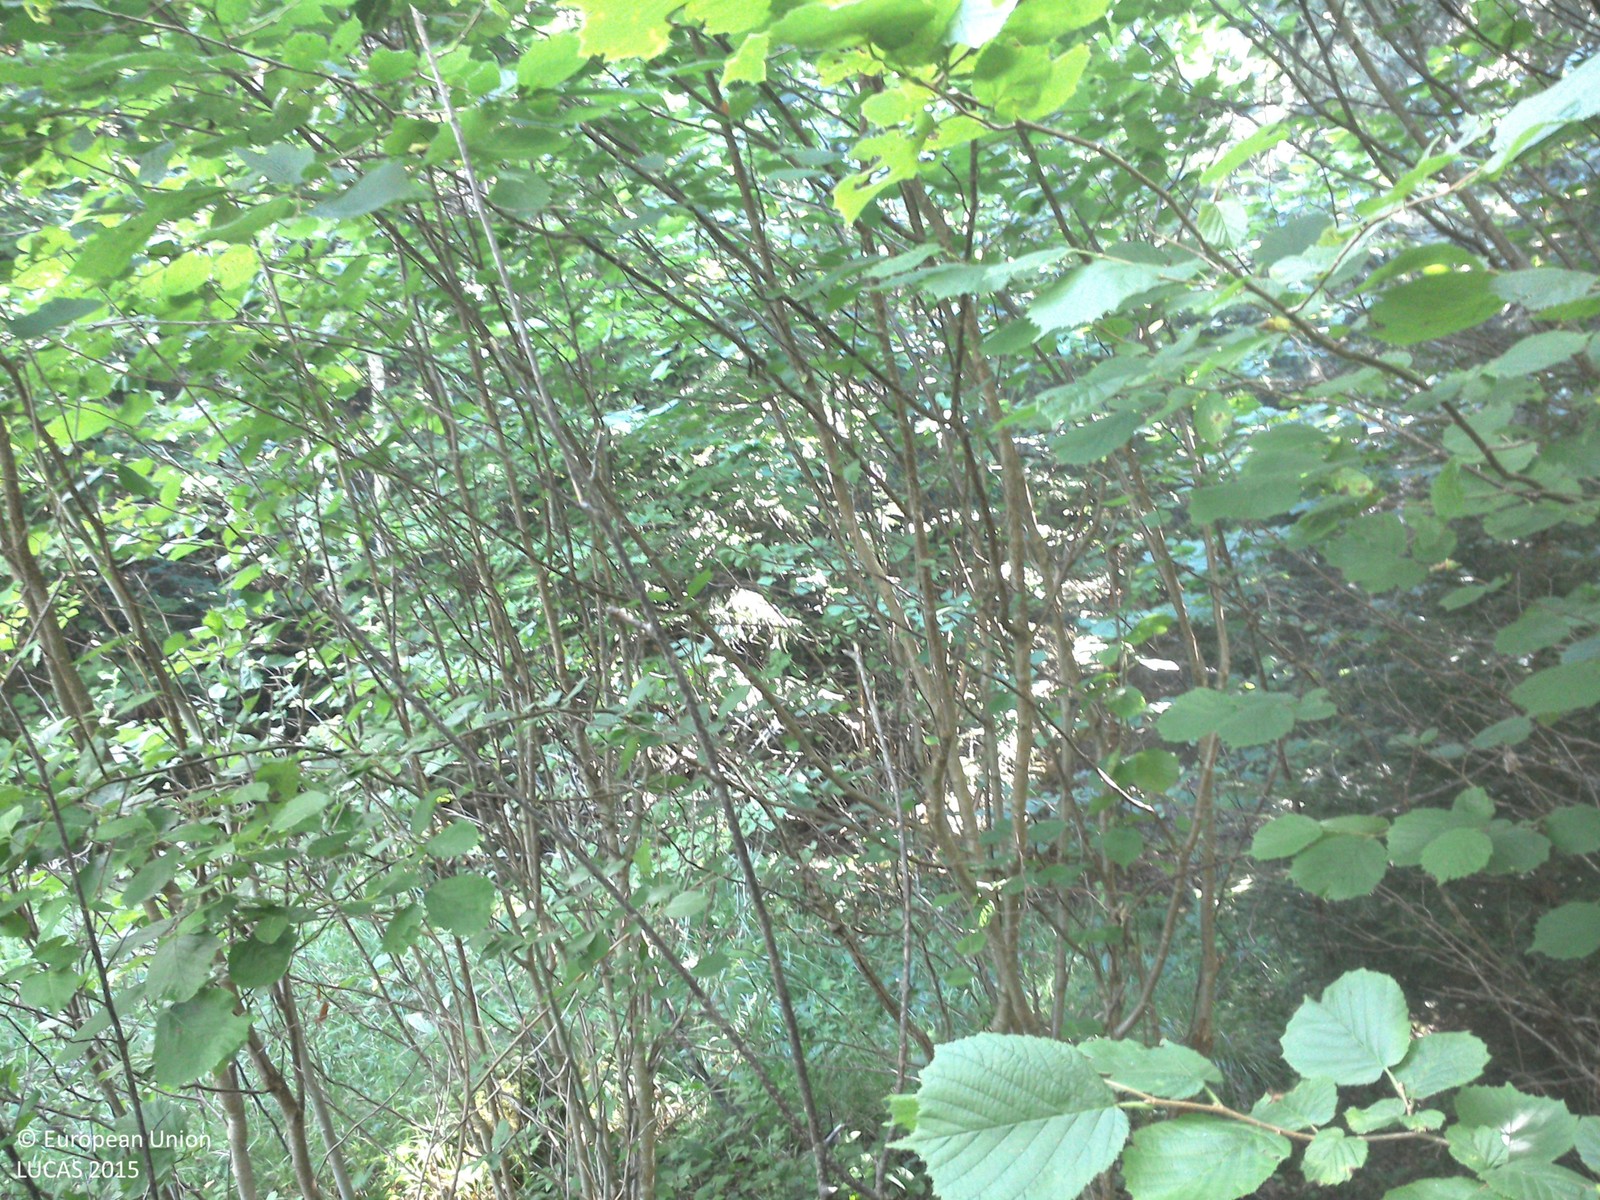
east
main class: Woodland
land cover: Spruce dominated mixed woodland
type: boreal forest
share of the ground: 50 - 75 %
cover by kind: coniferous forest trees 50 %, herbaceous plants 30 %, broadleaved forest trees 20 %
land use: Forestry
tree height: > 5 m
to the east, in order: Spruce dominated mixed woodland; Spruce dominated coniferous woodland; Ditches and canals; Pine dominated mixed woodland; Spruce dominated mixed woodland; Lichens and moss; Pine dominated coniferous woodland
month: August
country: SE
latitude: 58.0556
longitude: 15.4348
